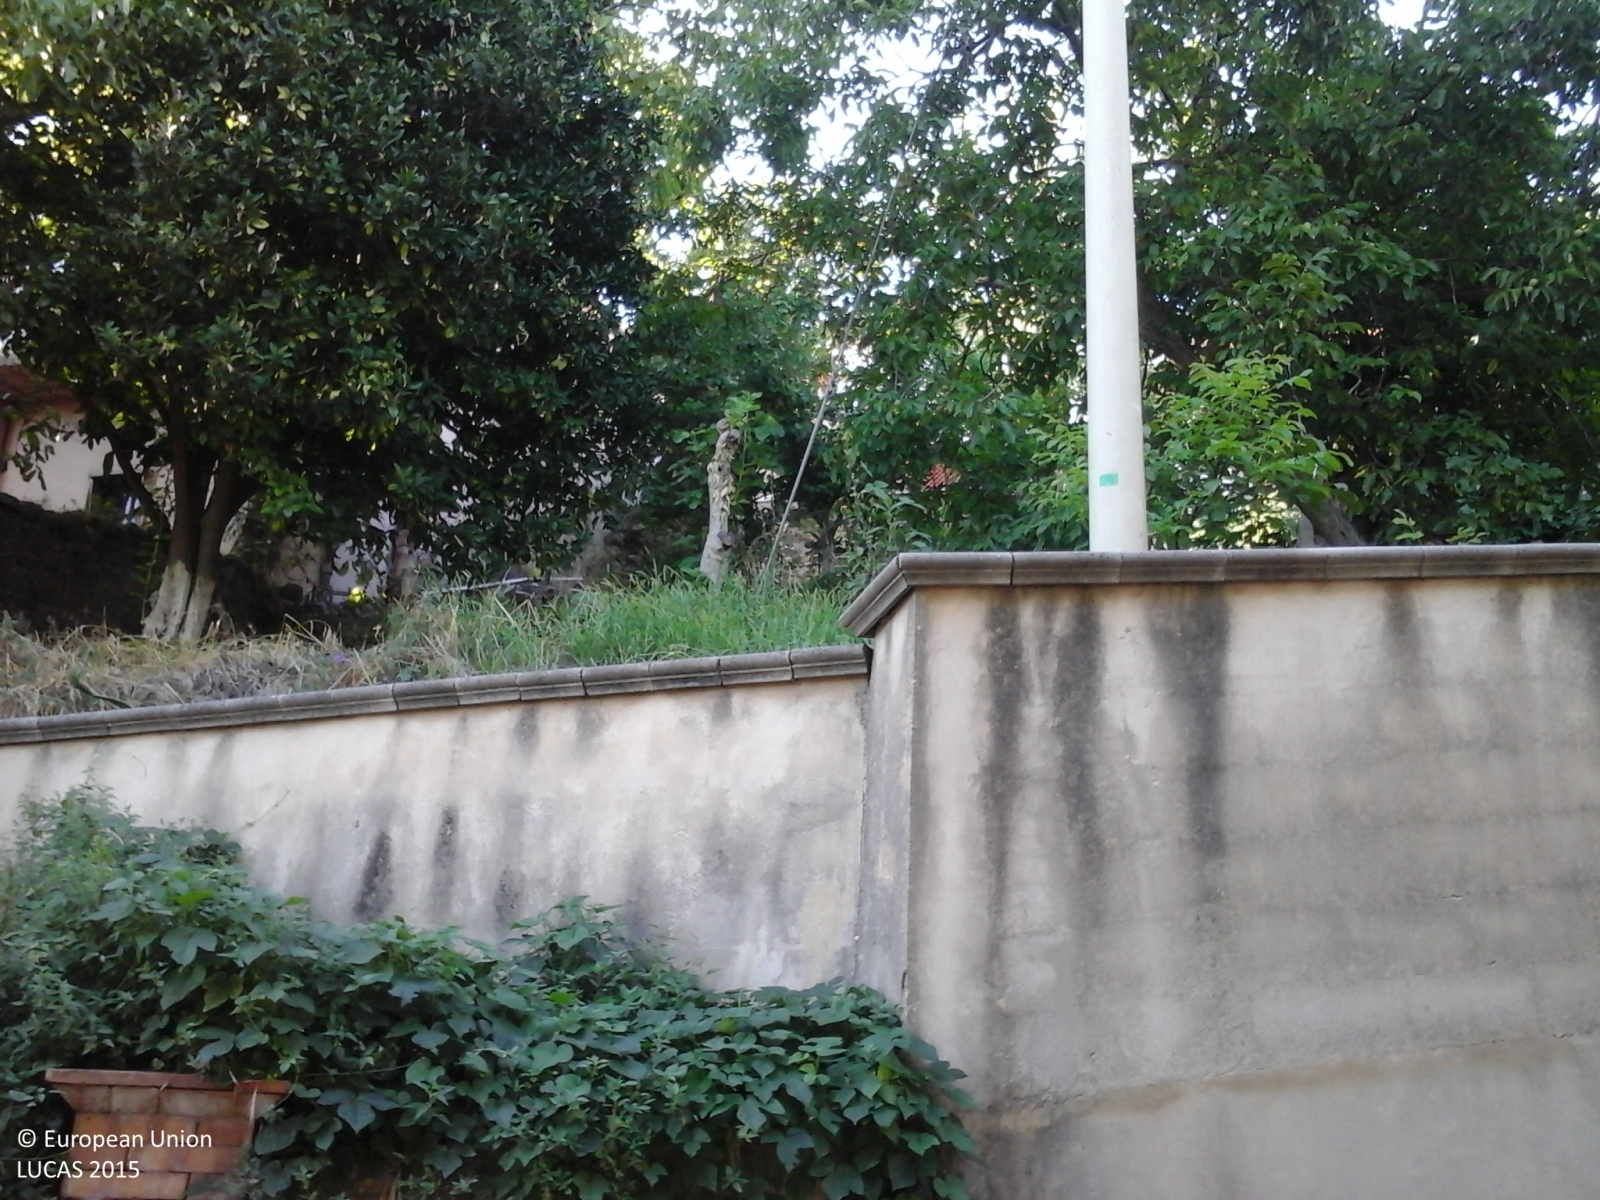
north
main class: Cropland
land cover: Other fruit trees and berries
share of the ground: > 75 %
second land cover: Spontaneously vegetated surfaces
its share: > 75 %
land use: Kitchen garden
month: August
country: IT
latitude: 40.2993
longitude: 15.0718
